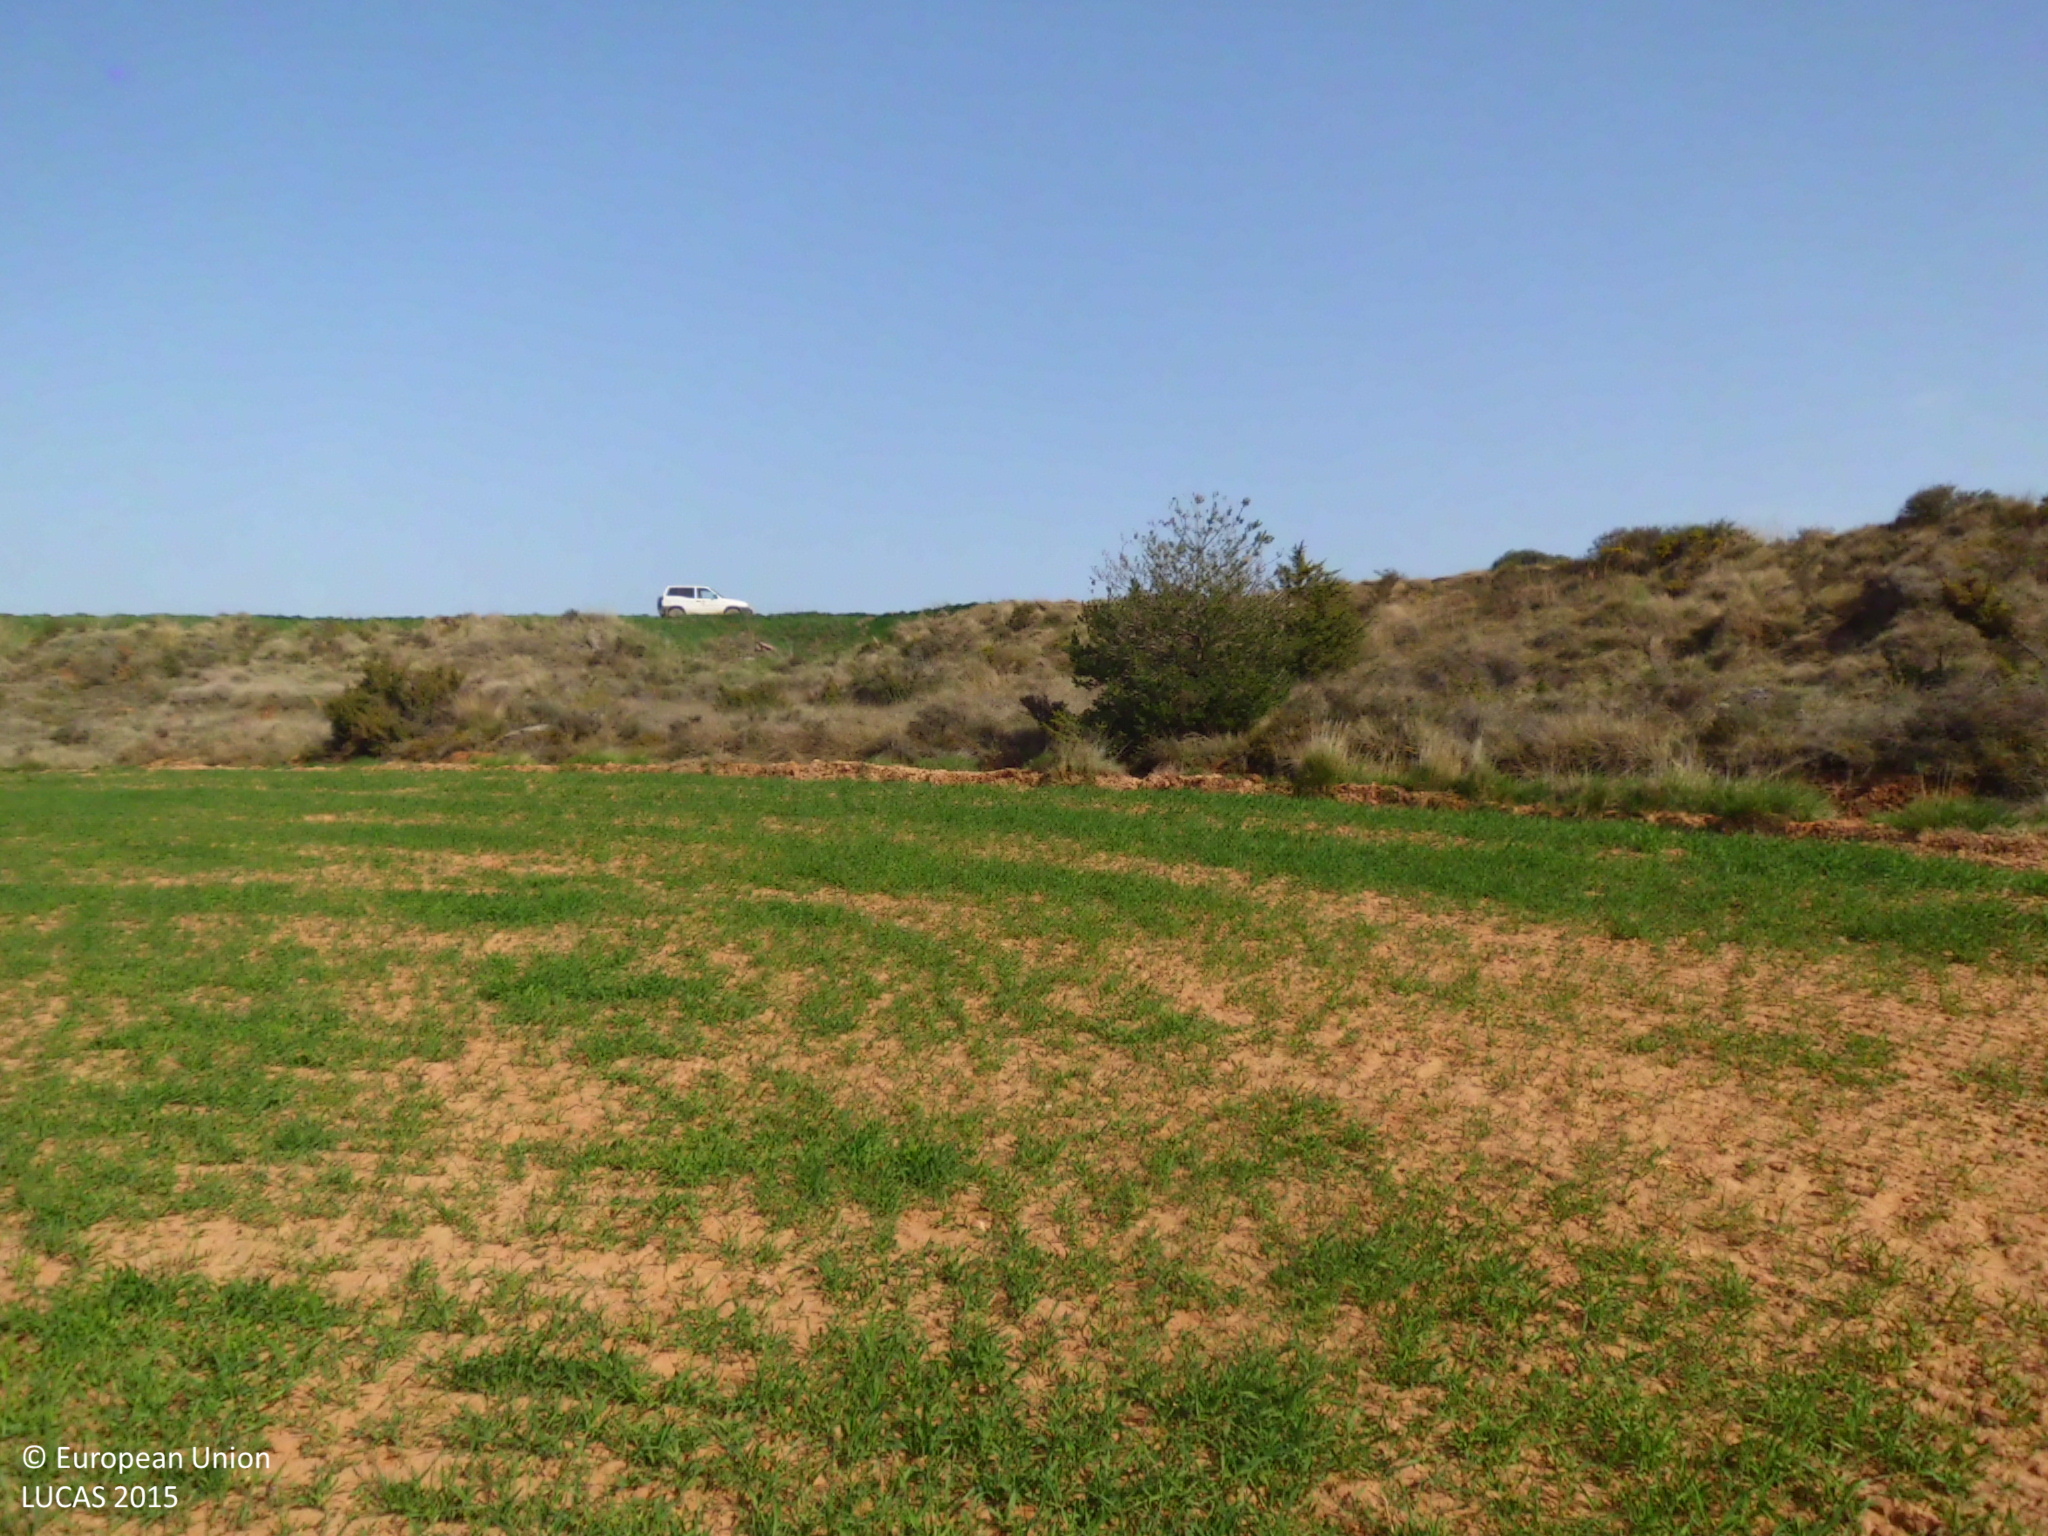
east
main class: Cropland
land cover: Barley
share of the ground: 50 - 75 %
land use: Agriculture (excluding fallow land and kitchen gardens)
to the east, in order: Barley; Grassland without tree/shrub cover; Other bare soil; Barley
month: April
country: ES
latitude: 42.5962
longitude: -3.4286
